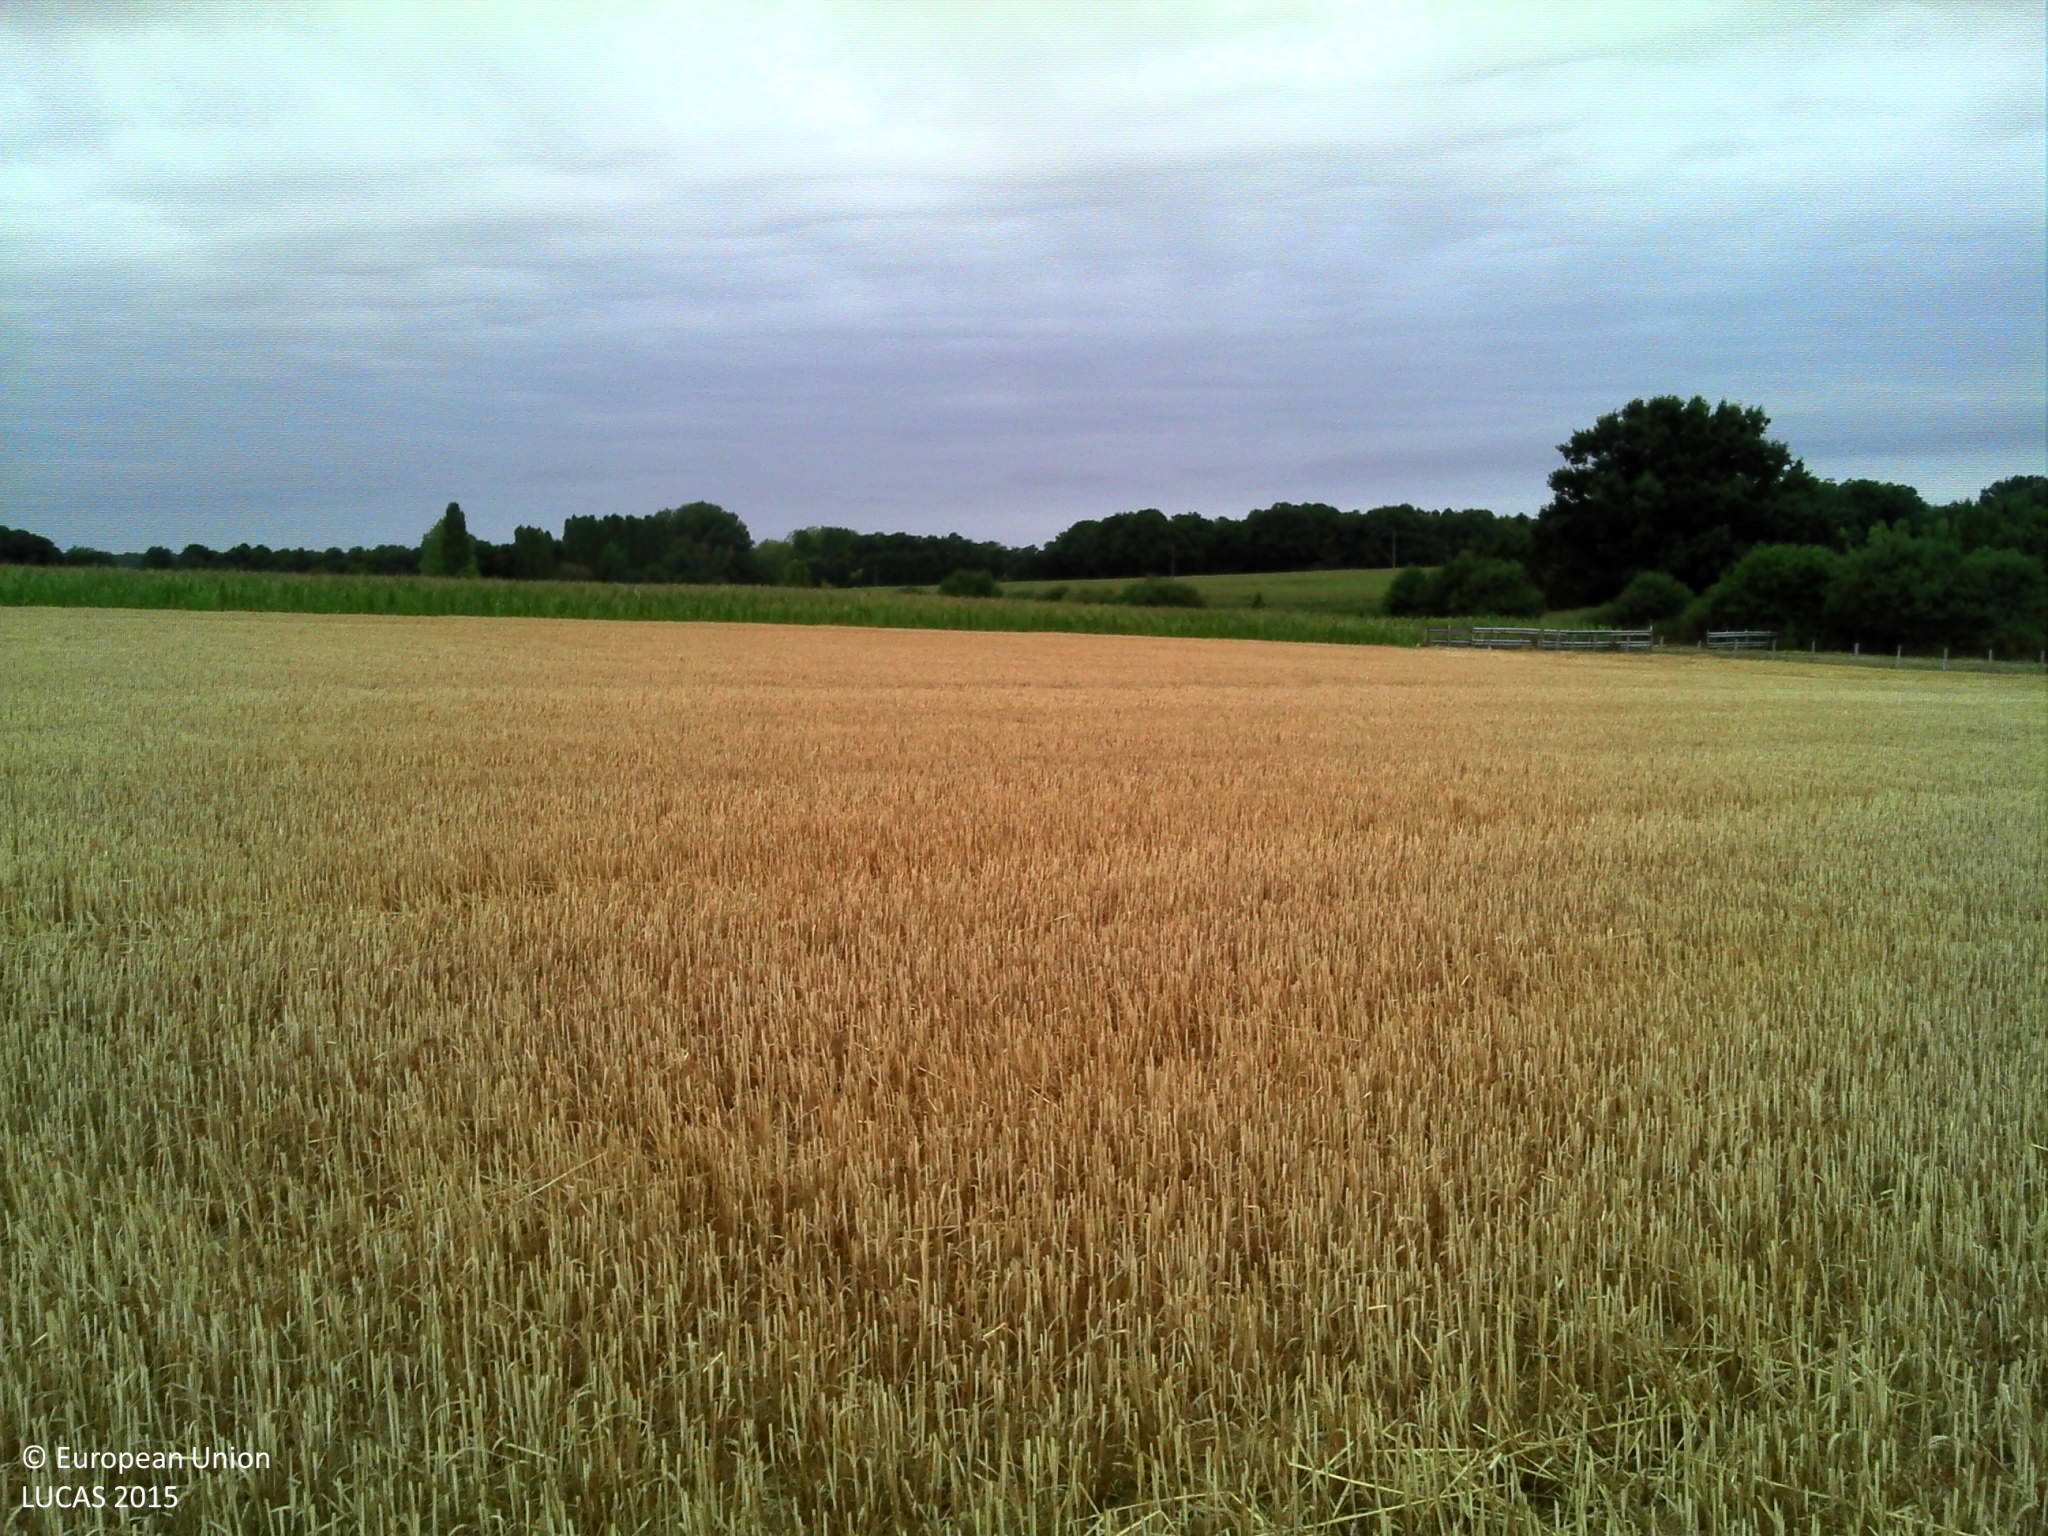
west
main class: Cropland
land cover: Common wheat
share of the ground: > 75 %
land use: Agriculture (excluding fallow land and kitchen gardens)
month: July
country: FR
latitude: 48.0262
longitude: 3.1144
